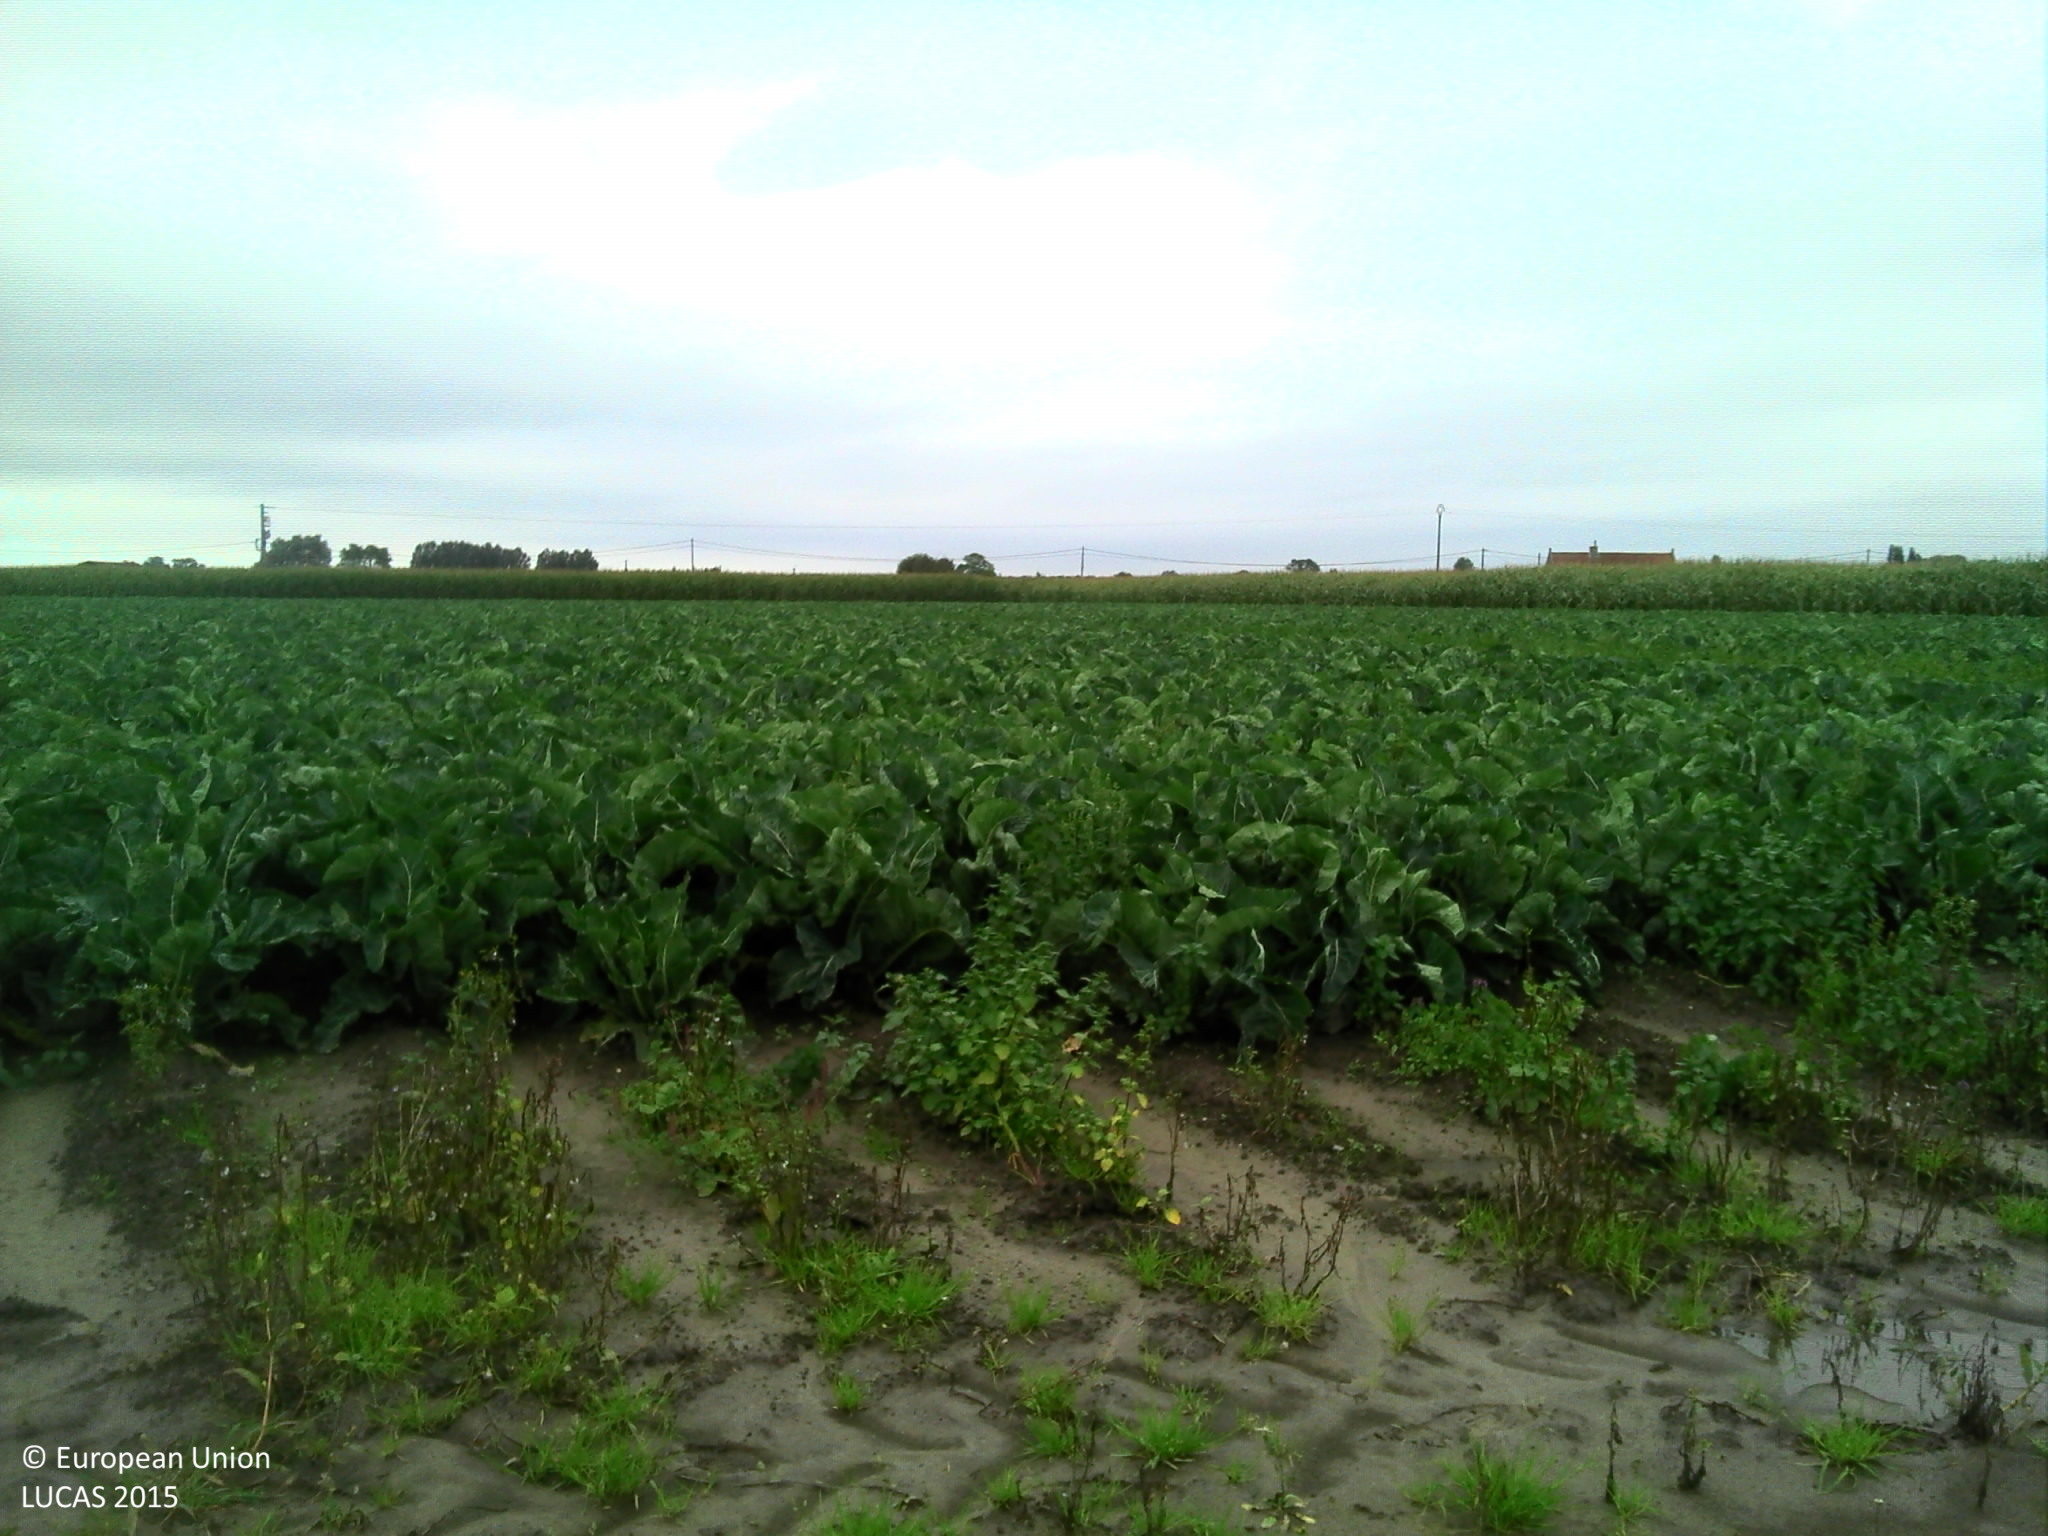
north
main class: Cropland
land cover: Maize
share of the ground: > 75 %
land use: Agriculture (excluding fallow land and kitchen gardens)
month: September
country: BE
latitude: 51.0620
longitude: 2.8691
